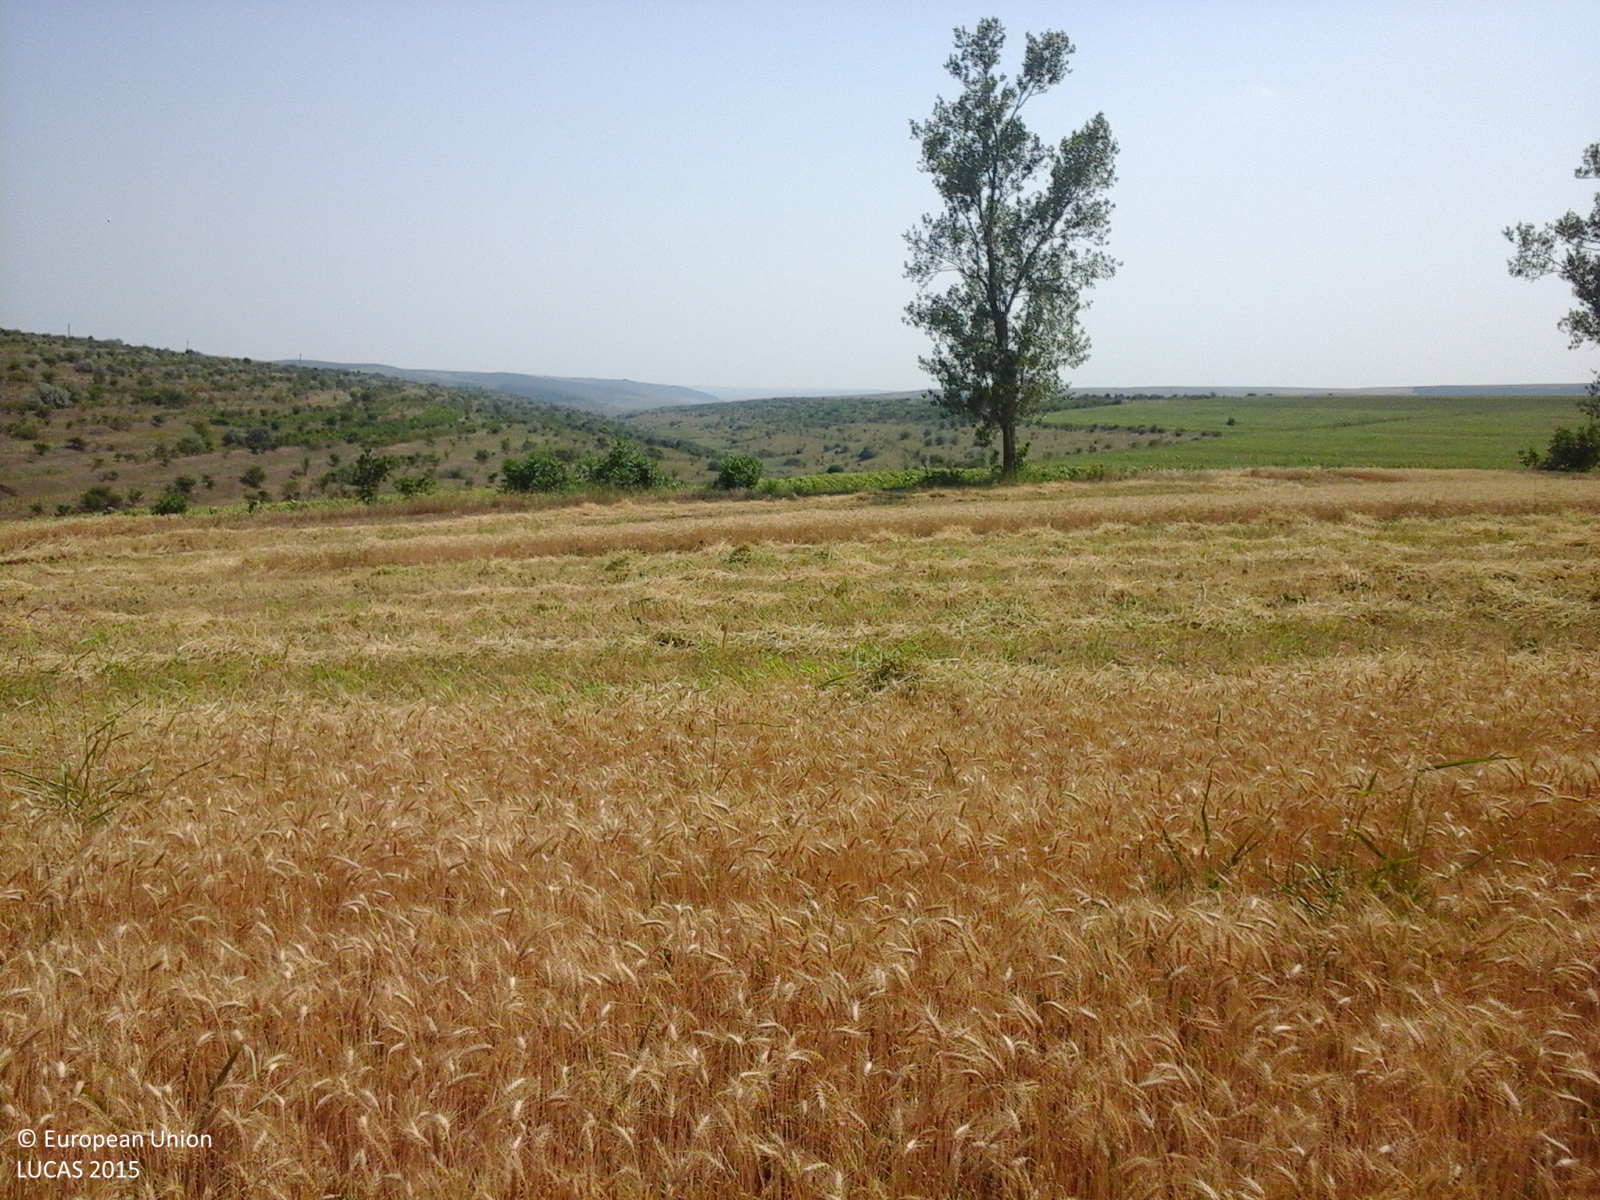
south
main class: Cropland
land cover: Durum wheat
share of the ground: > 75 %
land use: Agriculture (excluding fallow land and kitchen gardens)
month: July
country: RO
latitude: 45.9265
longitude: 28.0343
